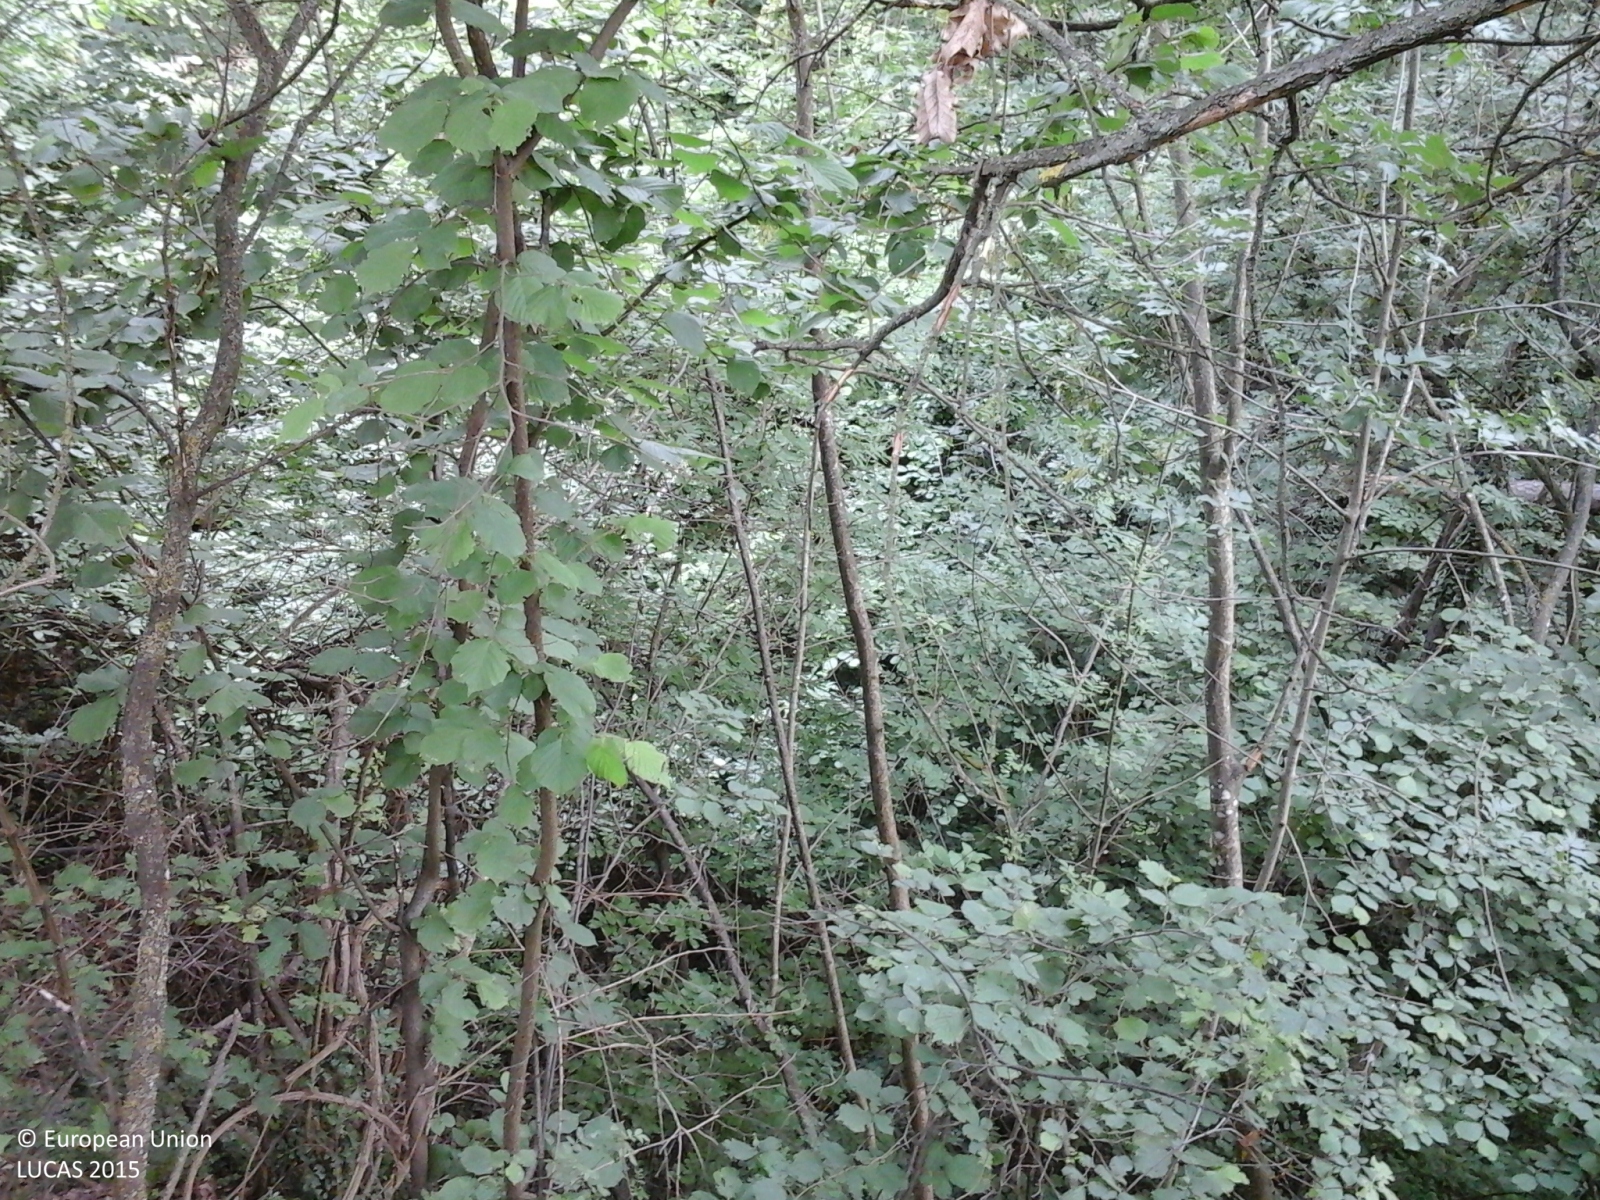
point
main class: Woodland
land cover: Broadleaved woodland
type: thermophilous deciduous forest
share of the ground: > 75 %
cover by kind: broadleaved forest trees 90 %, shrubs 10 %
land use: Forestry
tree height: > 5 m
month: May
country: IT
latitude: 44.6810
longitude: 8.4011
